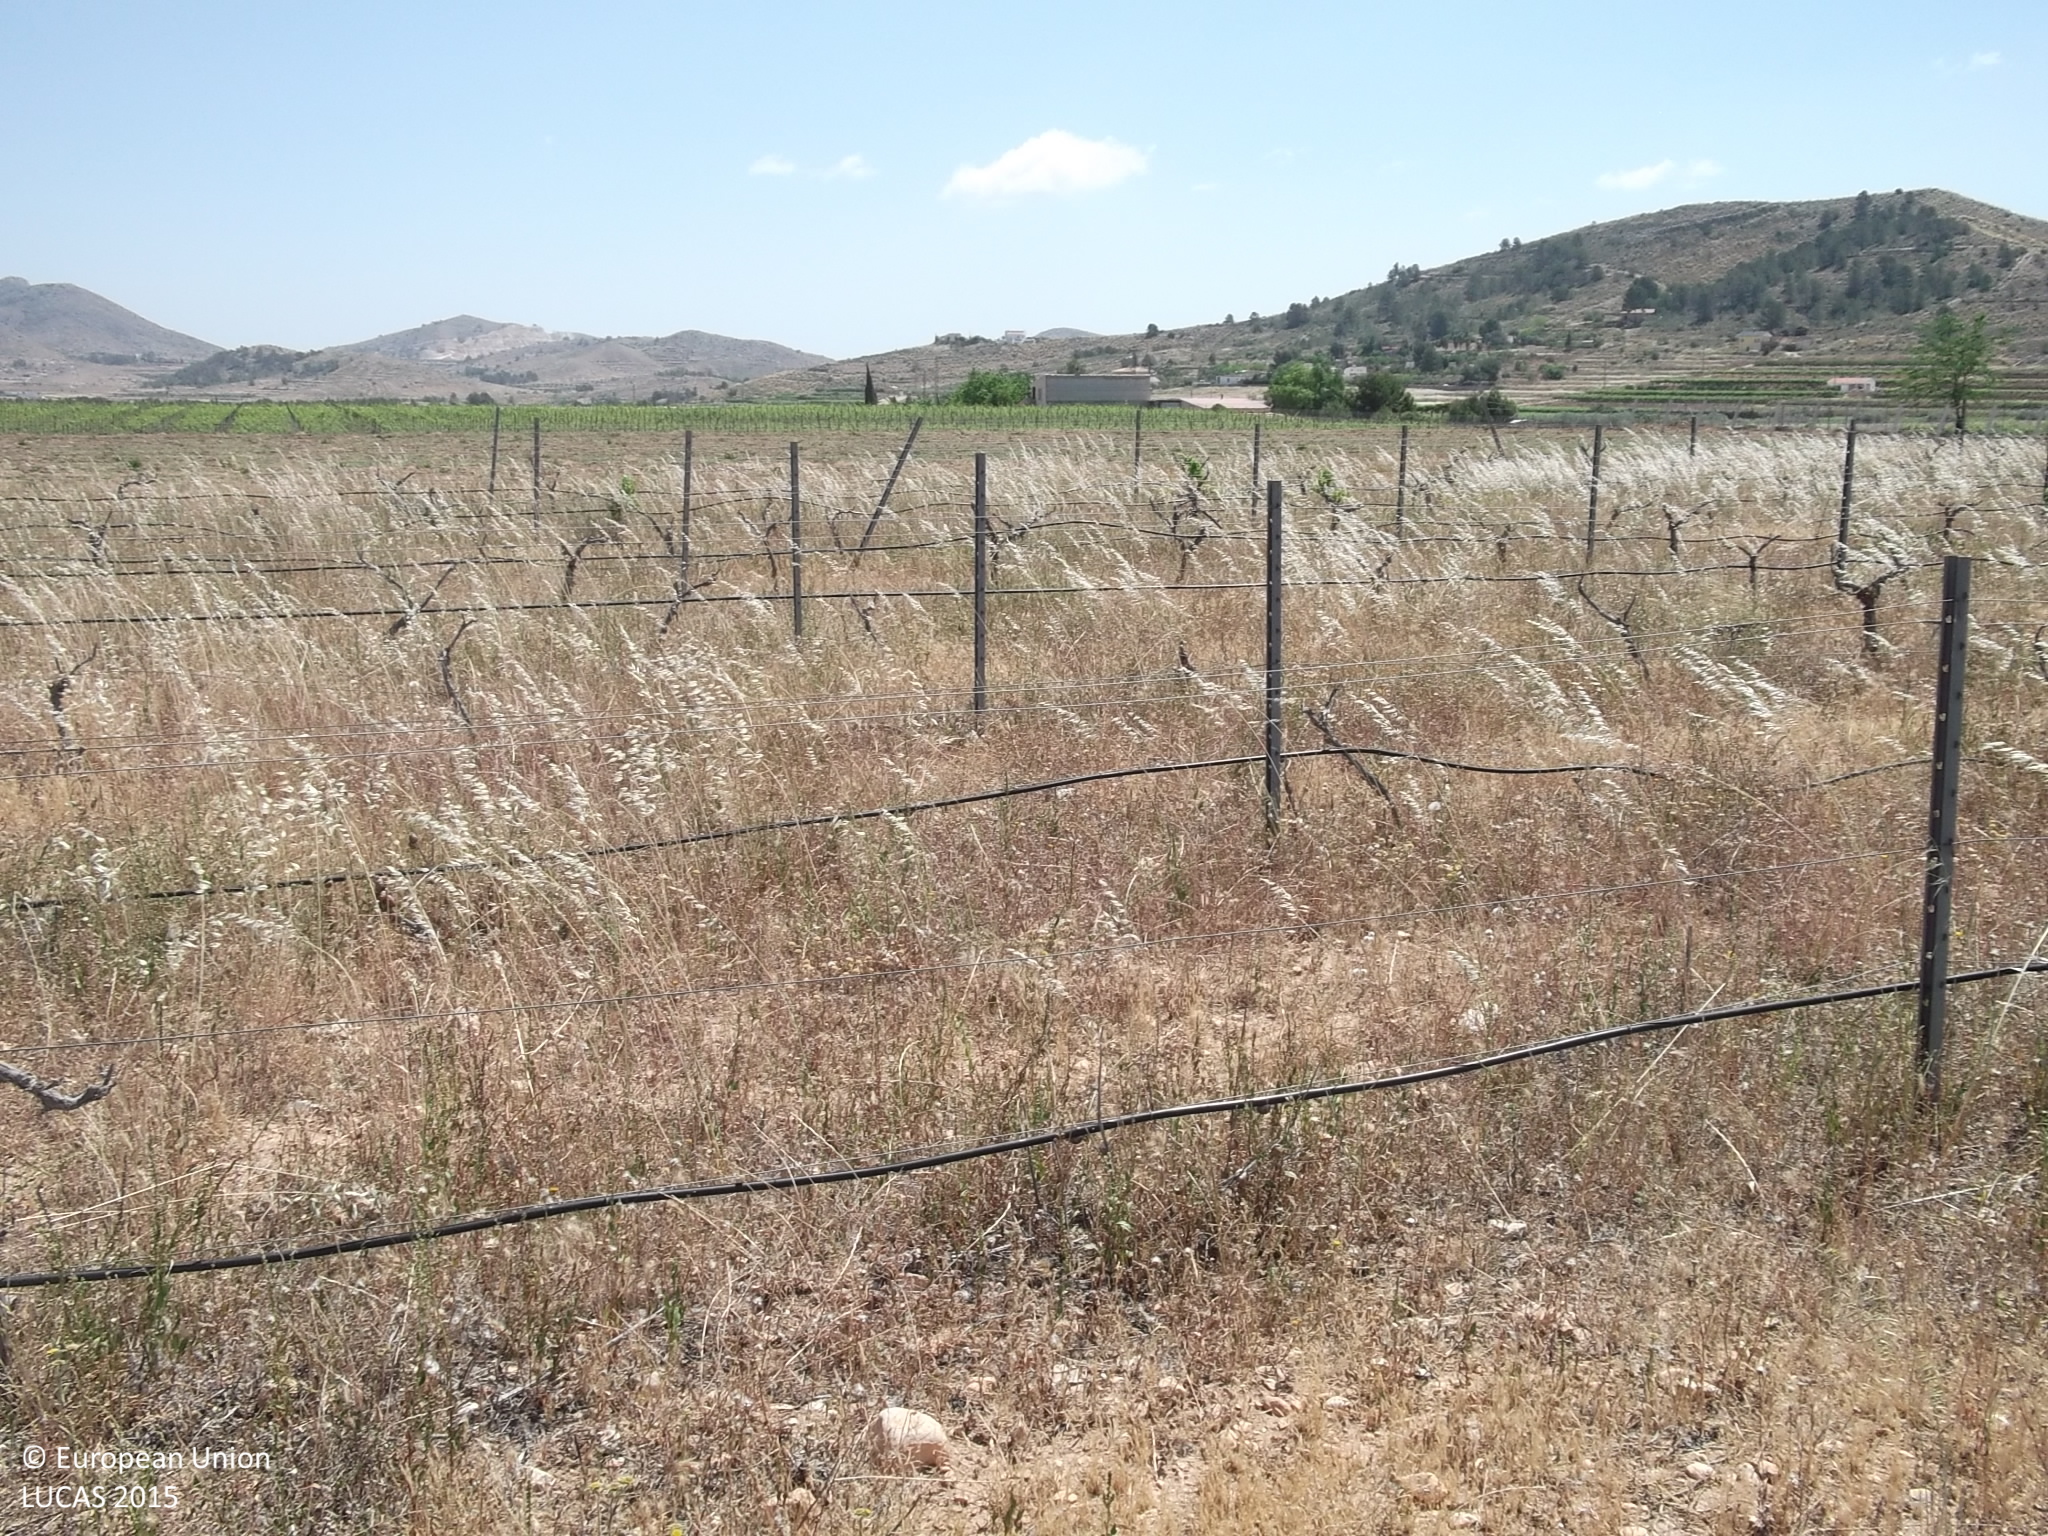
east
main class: Cropland
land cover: Vineyards
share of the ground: < 10 %
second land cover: Grassland without tree/shrub cover
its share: > 75 %
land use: Agriculture (excluding fallow land and kitchen gardens)
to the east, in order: Vineyards; Grassland without tree/shrub cover; Grass margins; Vineyards; Grass margins; Vineyards; Fences; Artificial constructions in urban areas; Pine dominated coniferous woodland
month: May
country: ES
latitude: 38.3088
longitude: -0.8853
